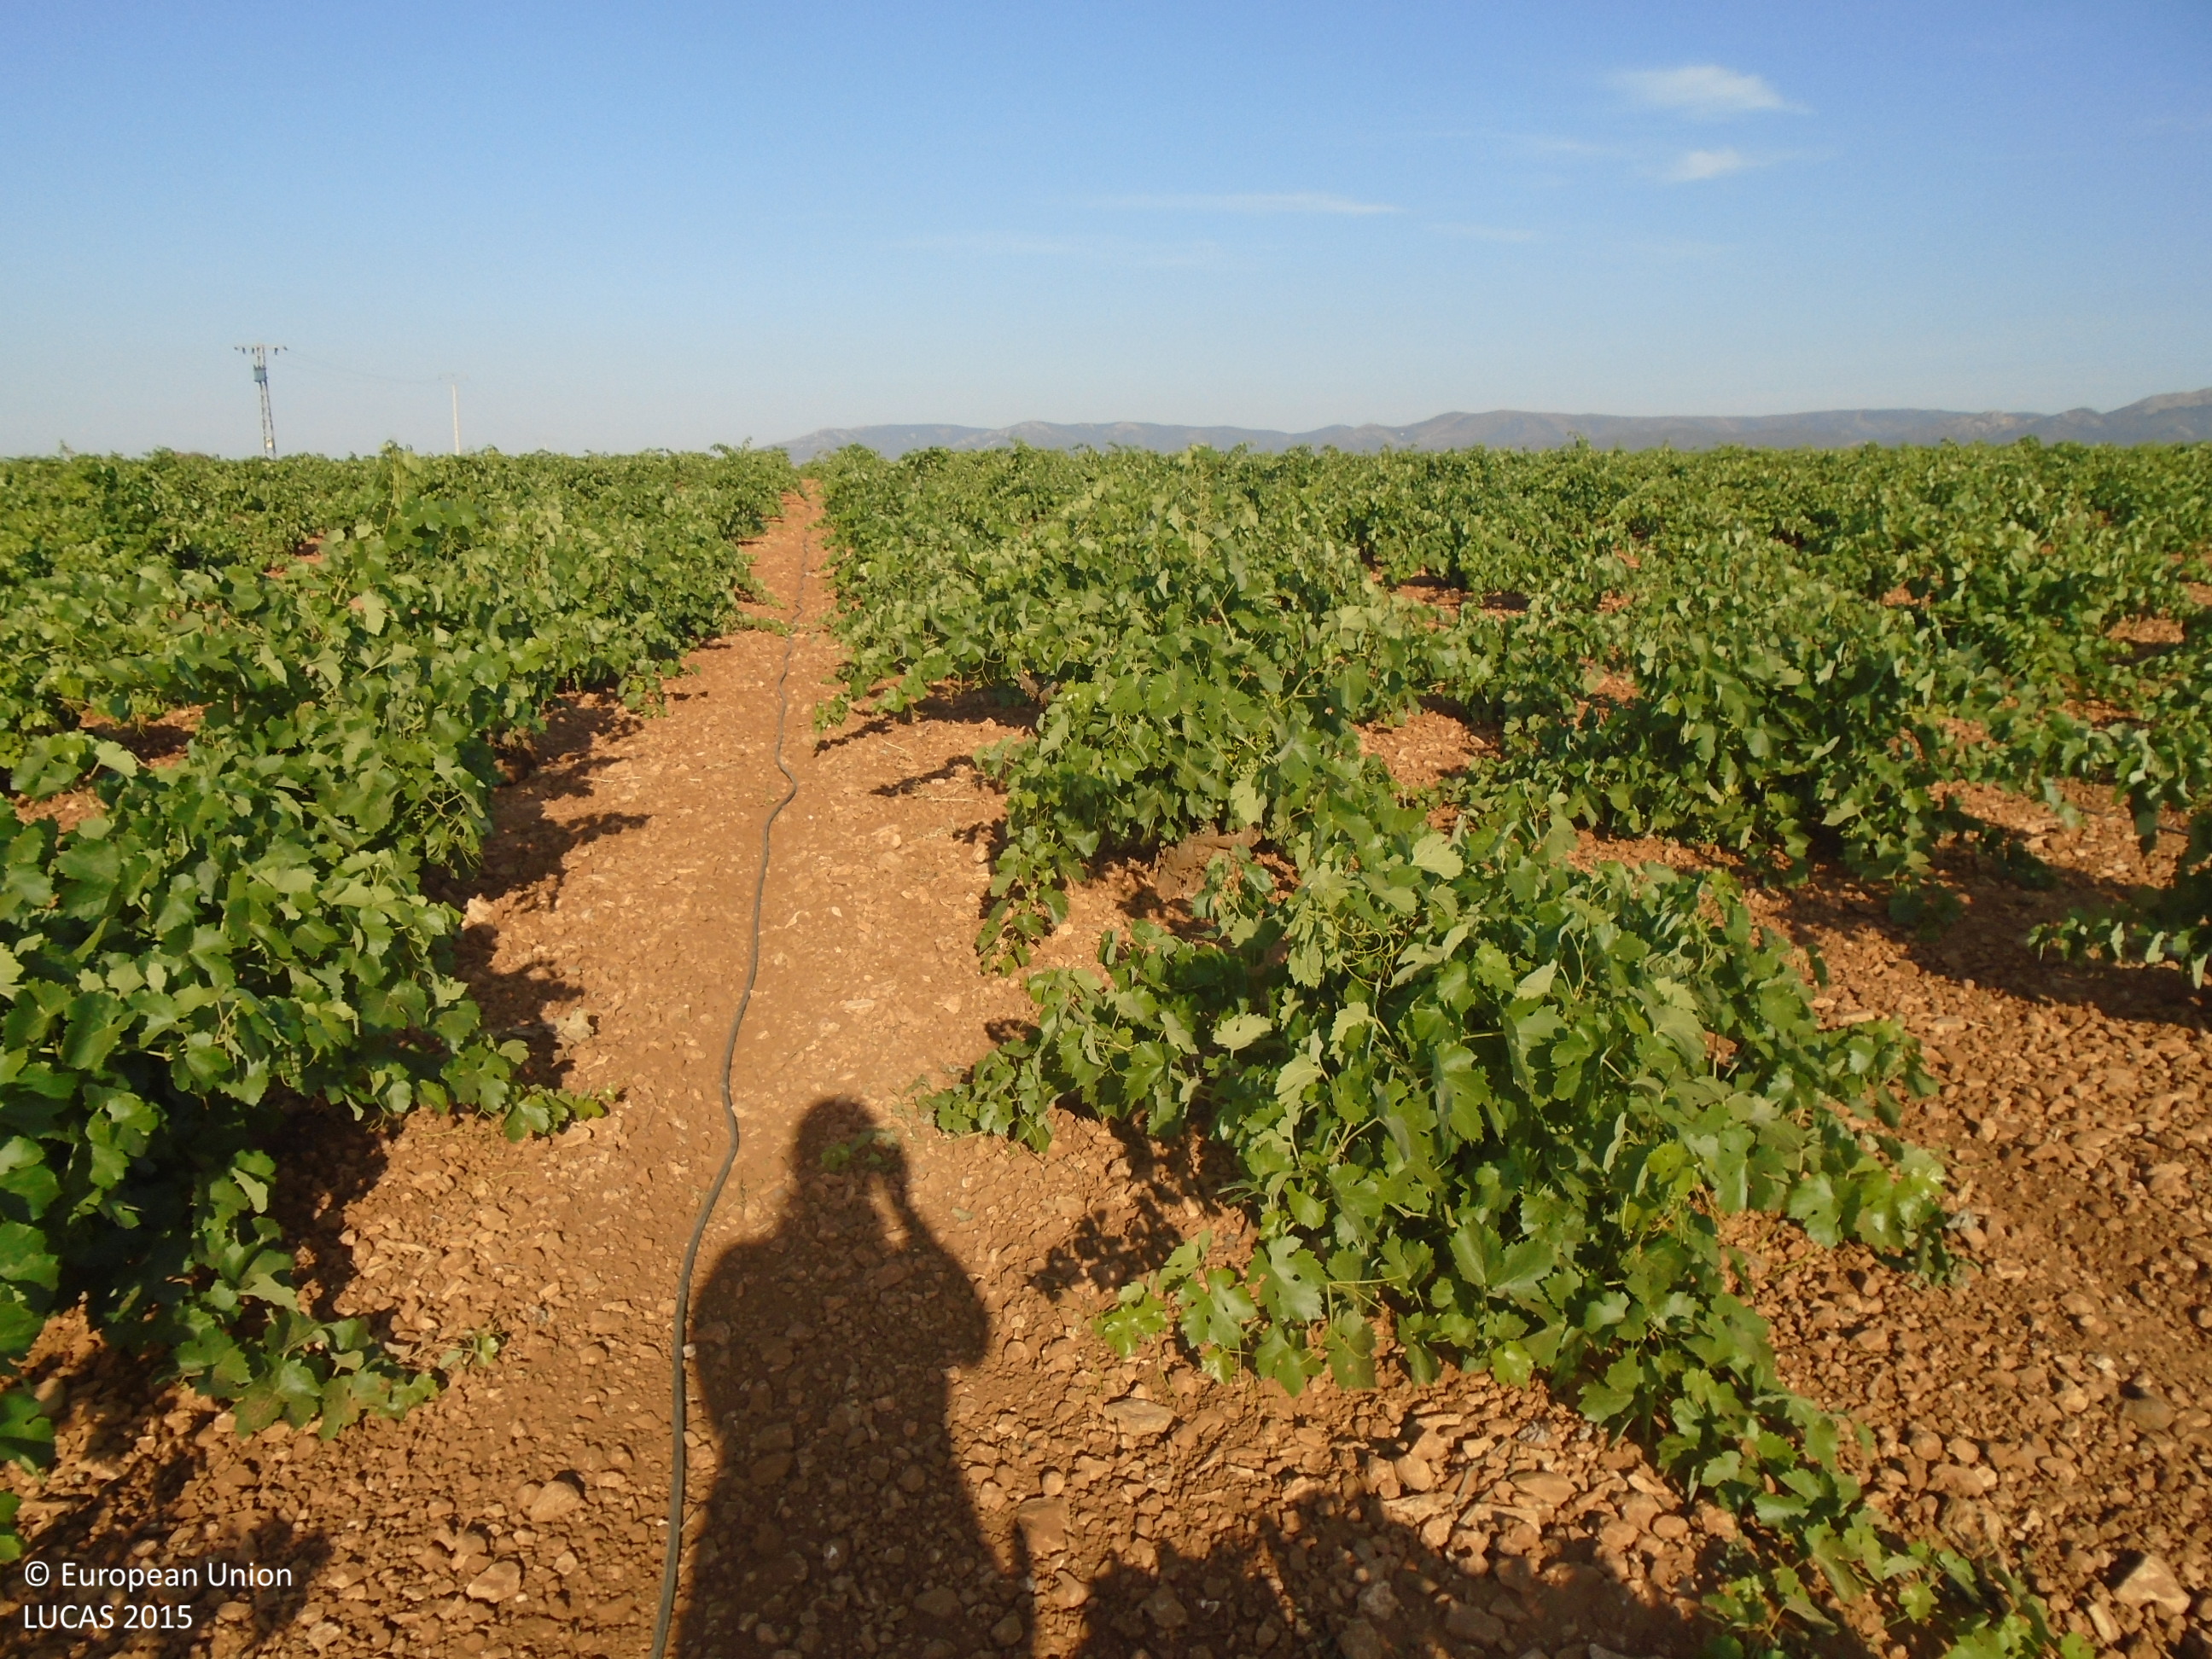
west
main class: Cropland
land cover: Vineyards
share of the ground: 25 - 50 %
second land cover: Other bare soil
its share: > 75 %
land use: Agriculture (excluding fallow land and kitchen gardens)
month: June
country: ES
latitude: 39.2599
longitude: -3.4741
